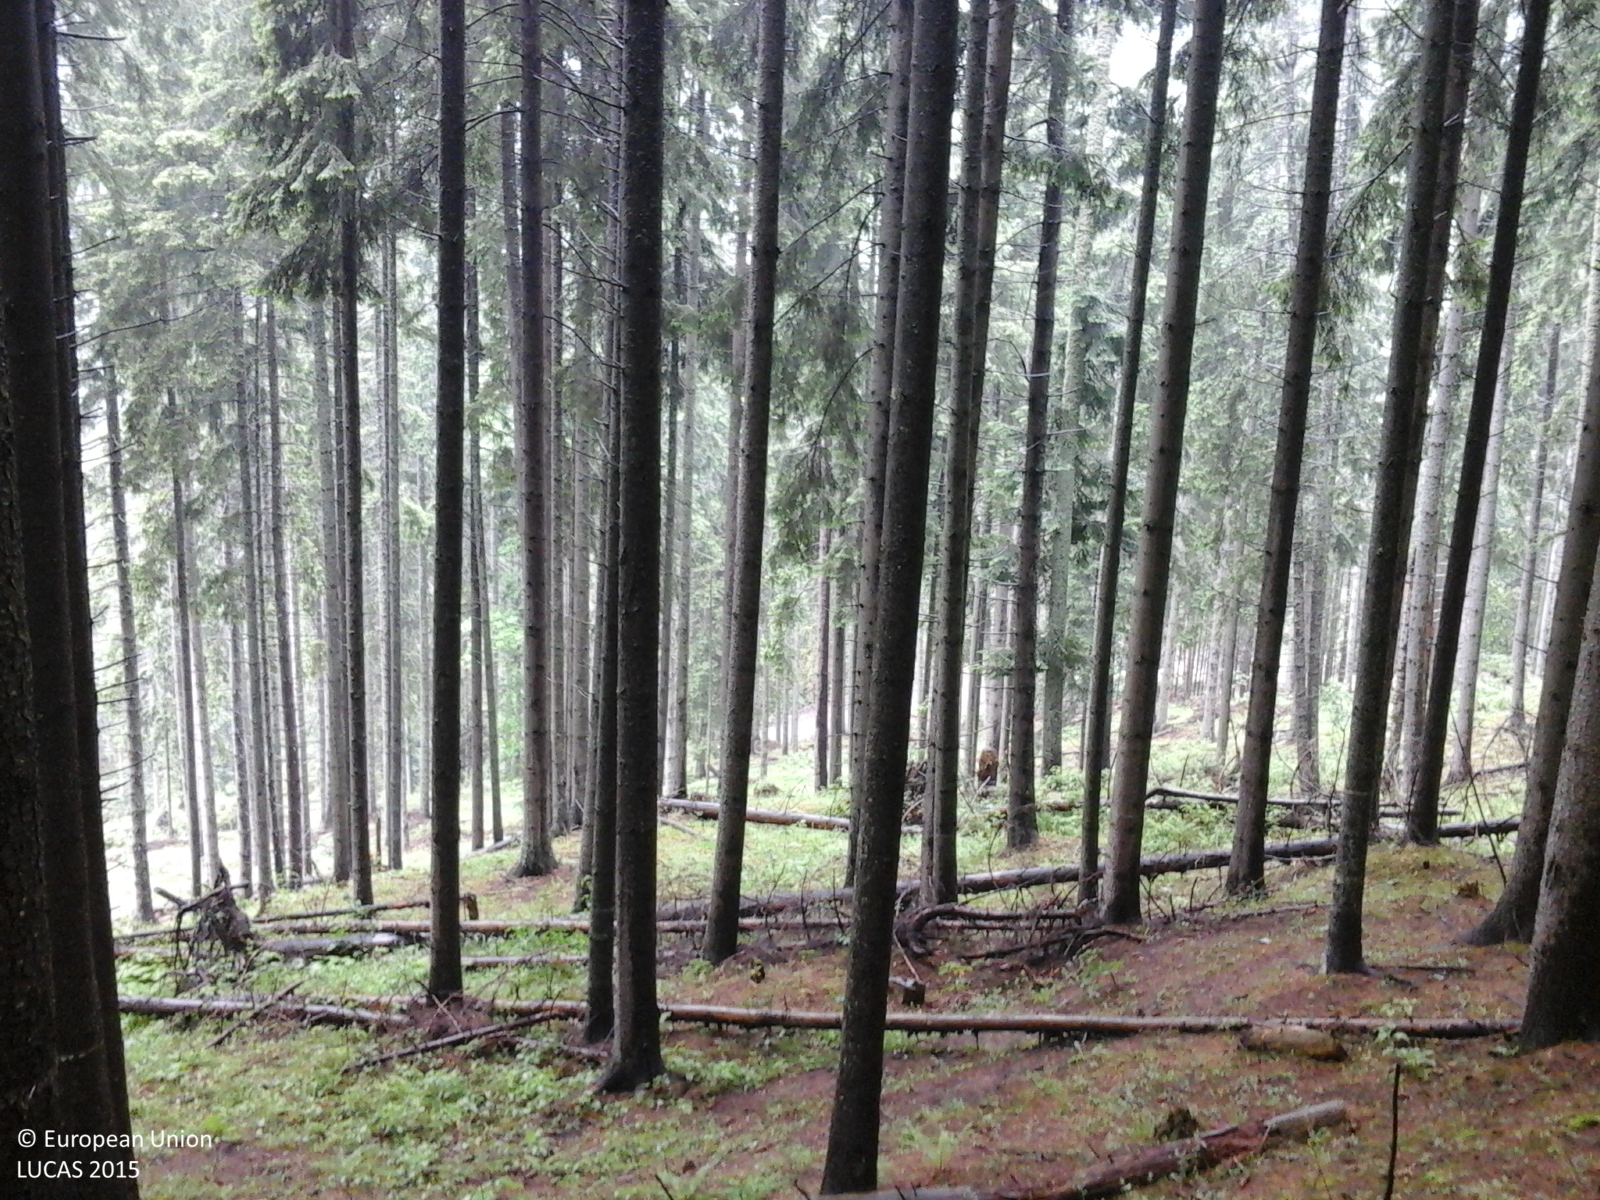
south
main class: Woodland
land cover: Spruce dominated coniferous woodland
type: alpine coniferous forest
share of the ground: > 75 %
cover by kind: coniferous forest trees 100 %
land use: Forestry
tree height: > 5 m
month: June
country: RO
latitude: 46.7219
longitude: 26.0735
